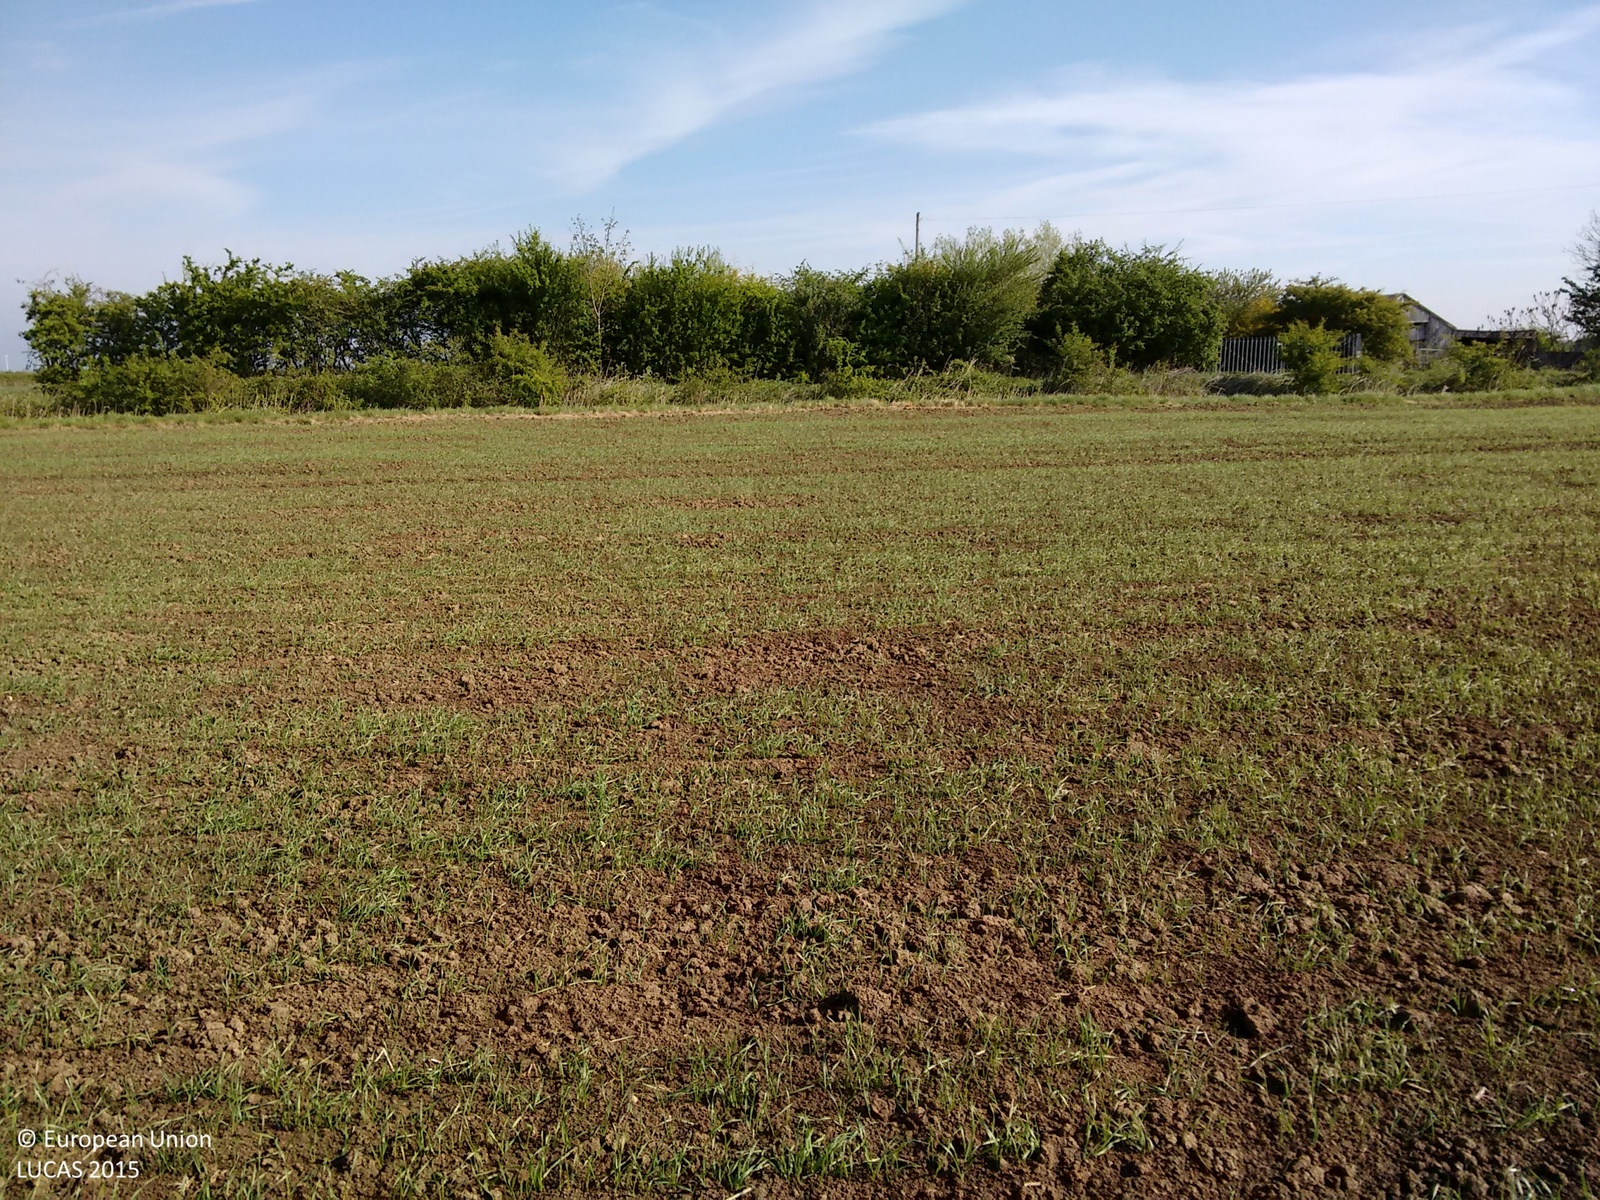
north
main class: Cropland
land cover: Common wheat
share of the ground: < 10 %
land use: Agriculture (excluding fallow land and kitchen gardens)
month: May
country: GB
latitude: 53.2807
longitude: 0.2670
